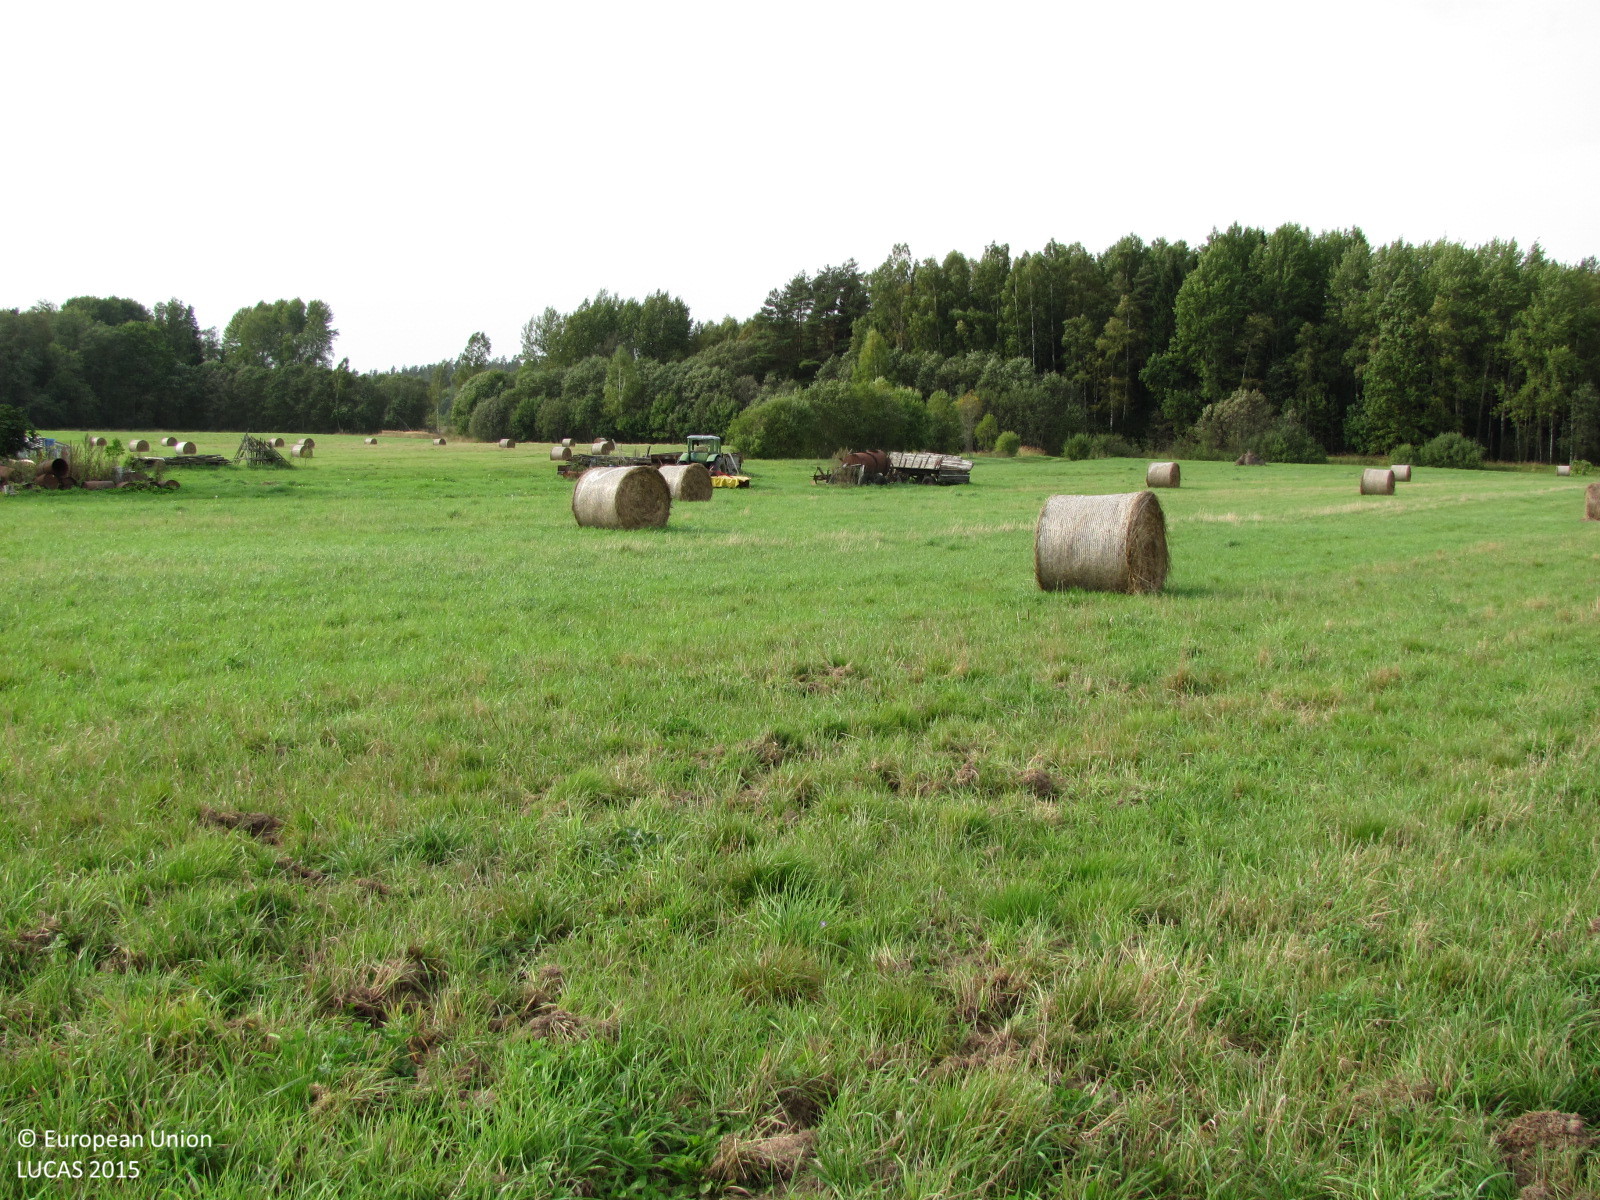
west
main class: Grassland
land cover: Grassland without tree/shrub cover
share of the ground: > 75 %
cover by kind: herbaceous plants 100 %
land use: Agriculture (excluding fallow land and kitchen gardens)
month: September
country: LV
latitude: 57.1600
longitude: 24.5950
